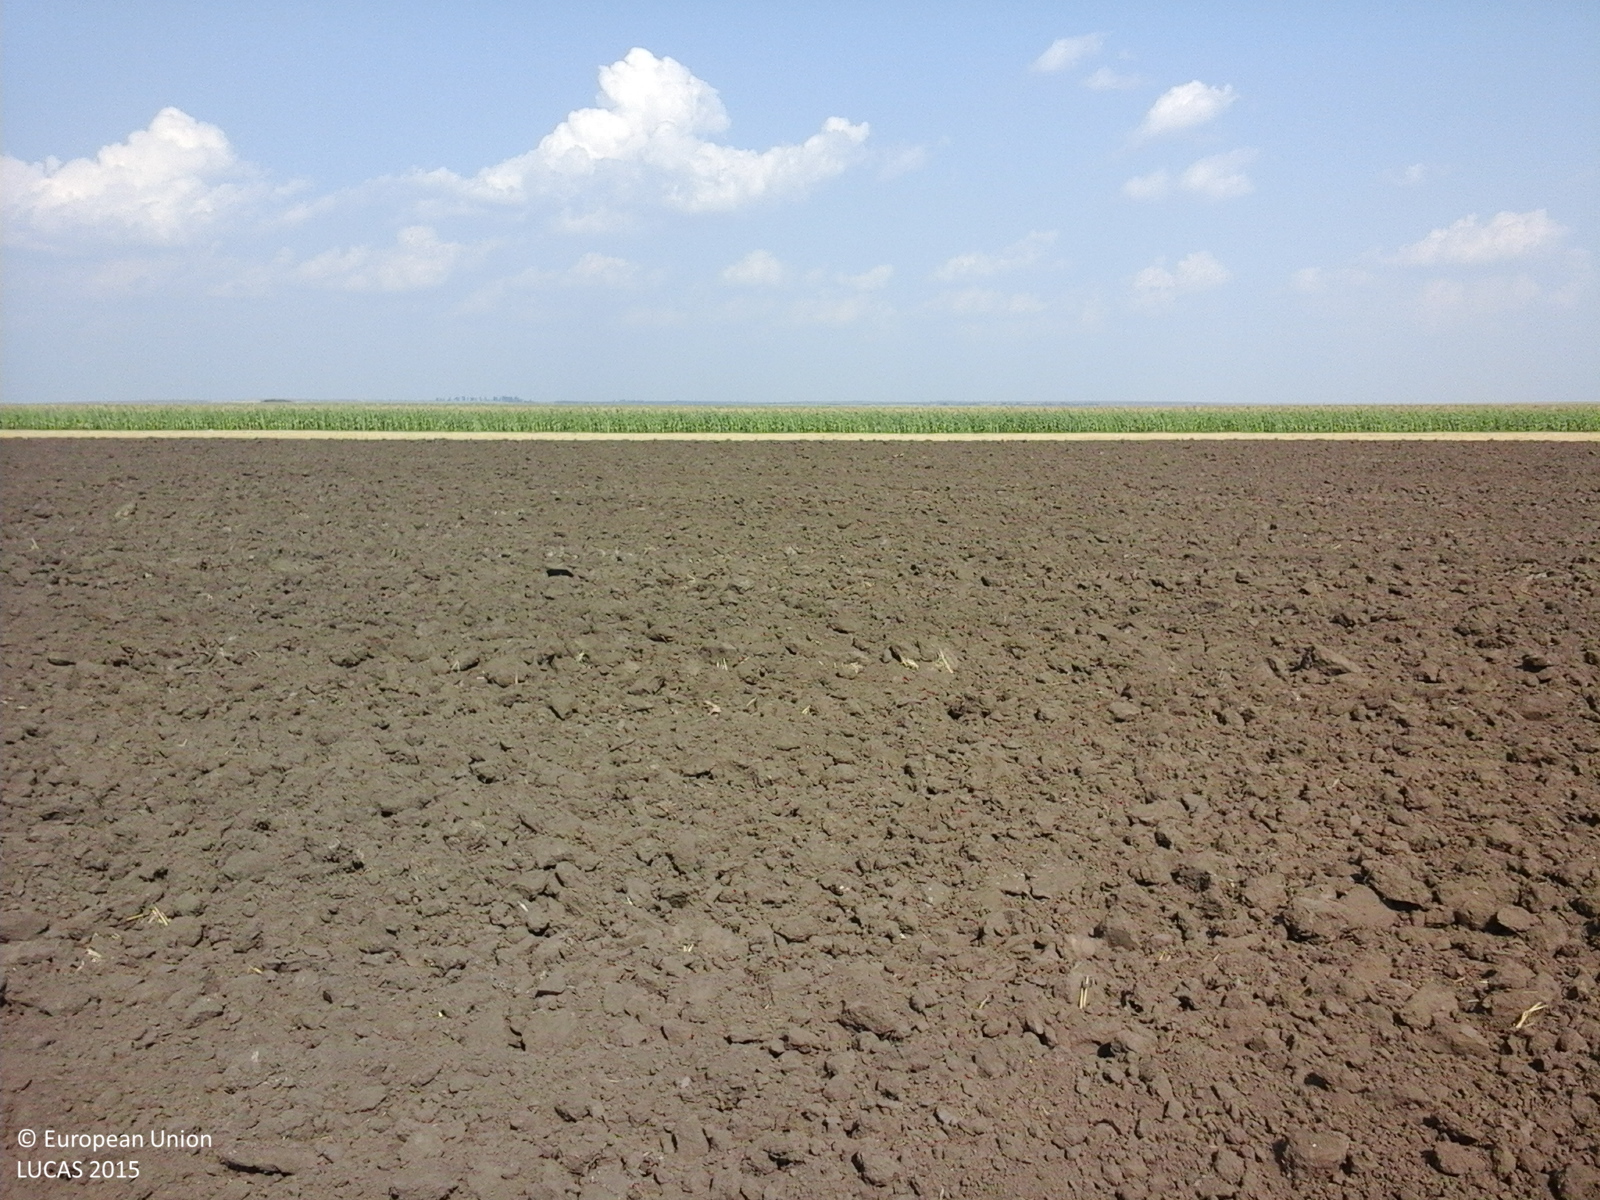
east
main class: Cropland
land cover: Common wheat
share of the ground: < 10 %
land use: Agriculture (excluding fallow land and kitchen gardens)
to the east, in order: Common wheat; Maize; Grass margins; Tracks; Grass margins; Maize
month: July
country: RO
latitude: 45.9947
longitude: 27.5246
